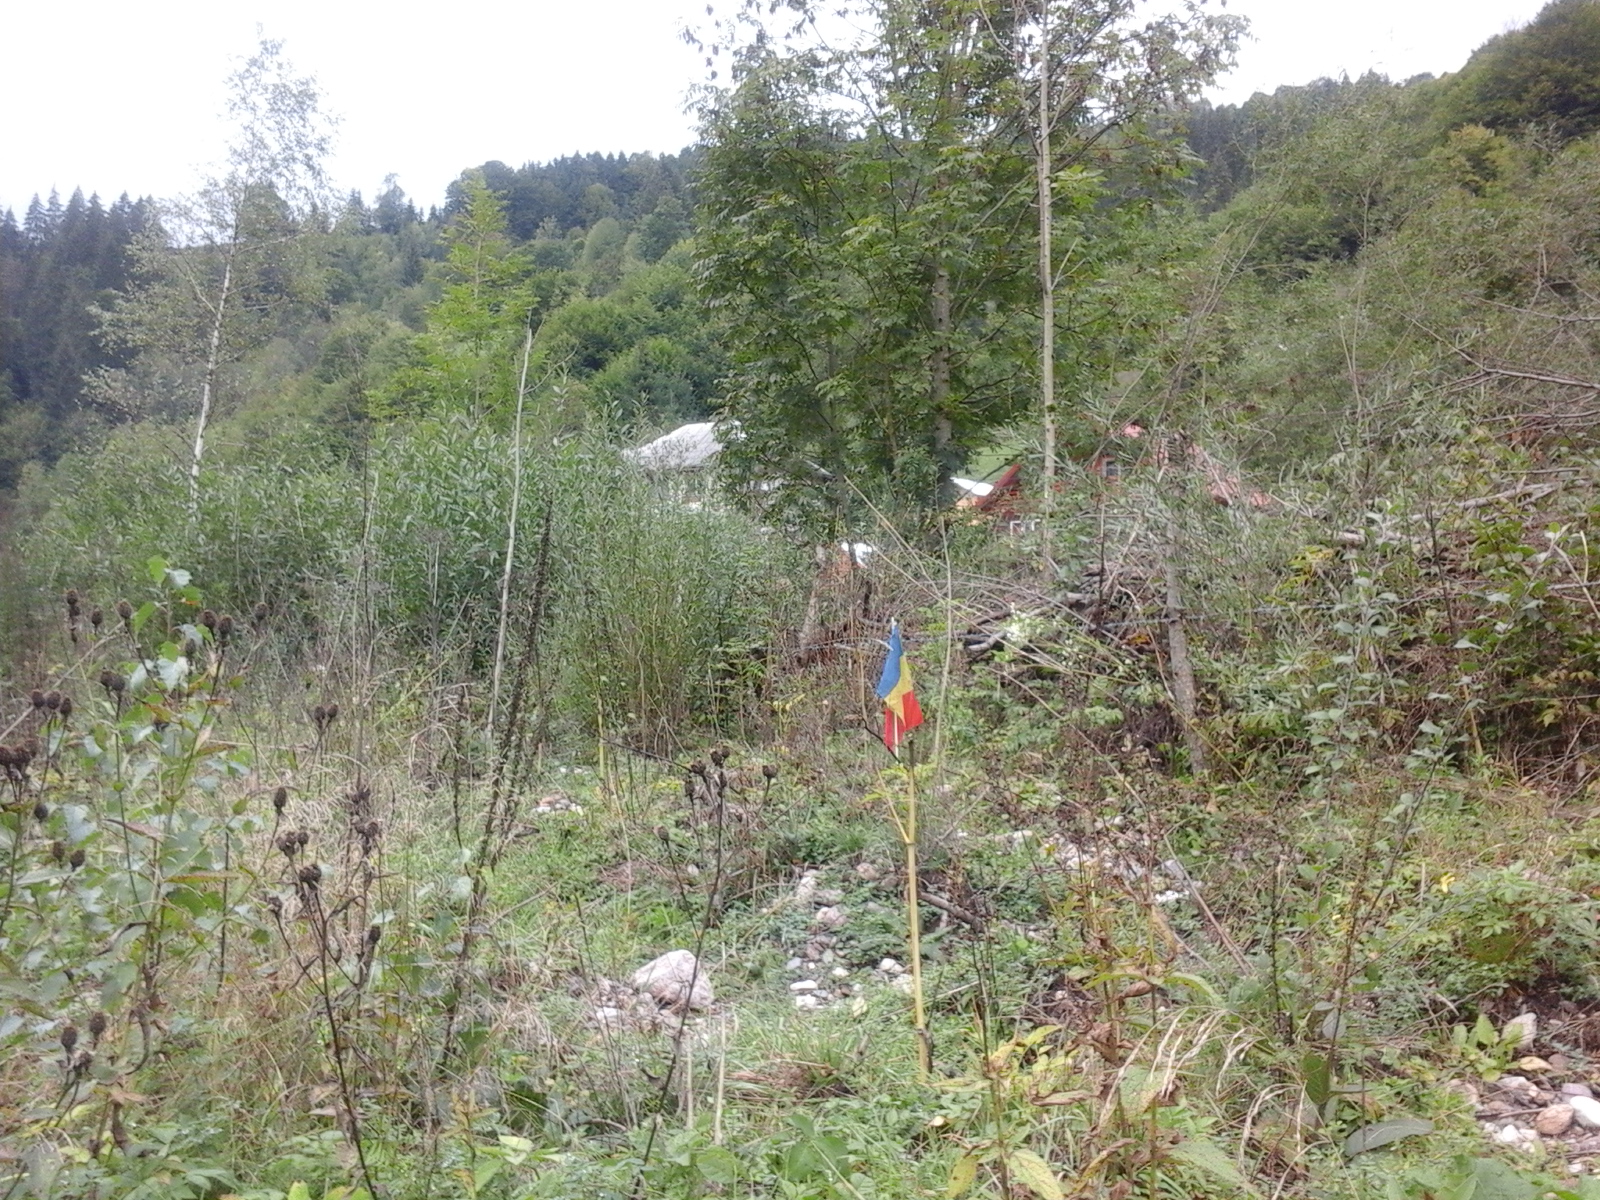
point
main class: Grassland
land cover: Spontaneously vegetated surfaces
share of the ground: > 75 %
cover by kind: herbaceous plants 100 %
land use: Semi-natural and natural areas not in use
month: September
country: RO
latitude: 46.4616
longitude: 22.8829
